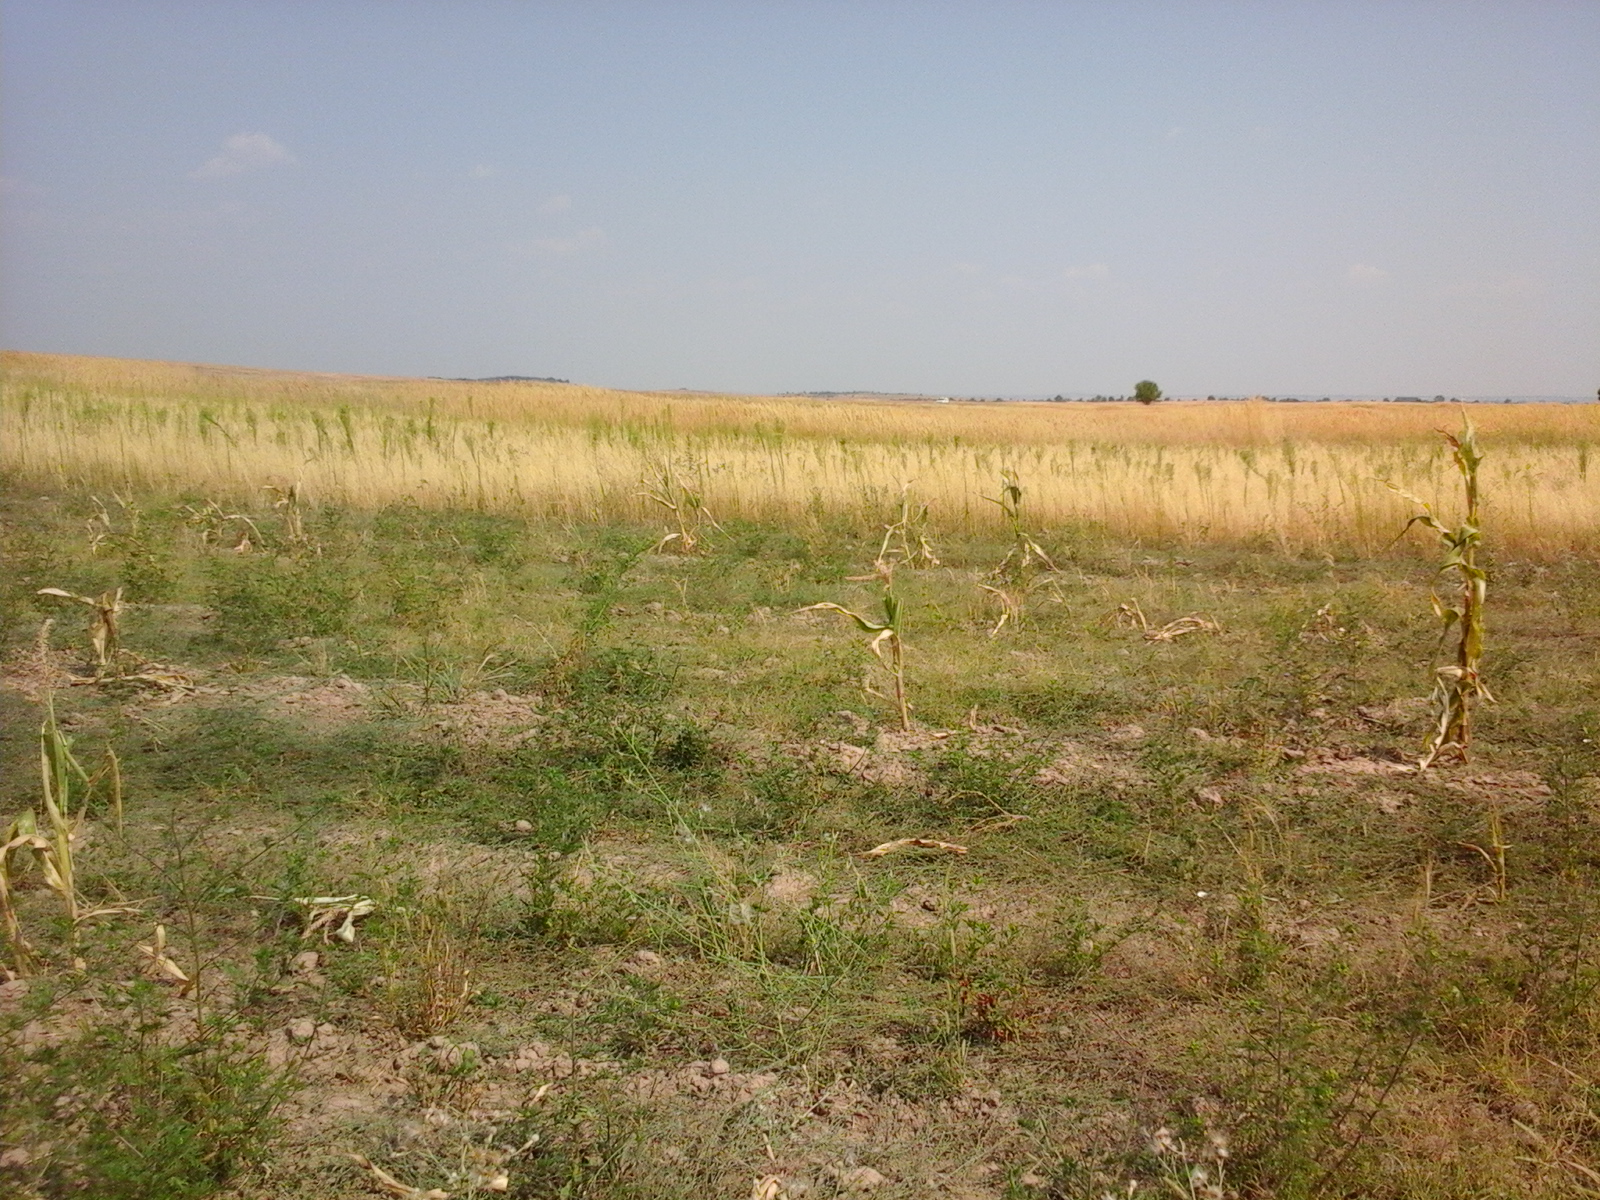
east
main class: Grassland
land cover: Spontaneously vegetated surfaces
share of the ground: > 75 %
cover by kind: herbaceous plants 100 %
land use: Fallow land
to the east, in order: Spontaneously vegetated surfaces
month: August
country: RO
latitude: 44.4815
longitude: 22.6765
